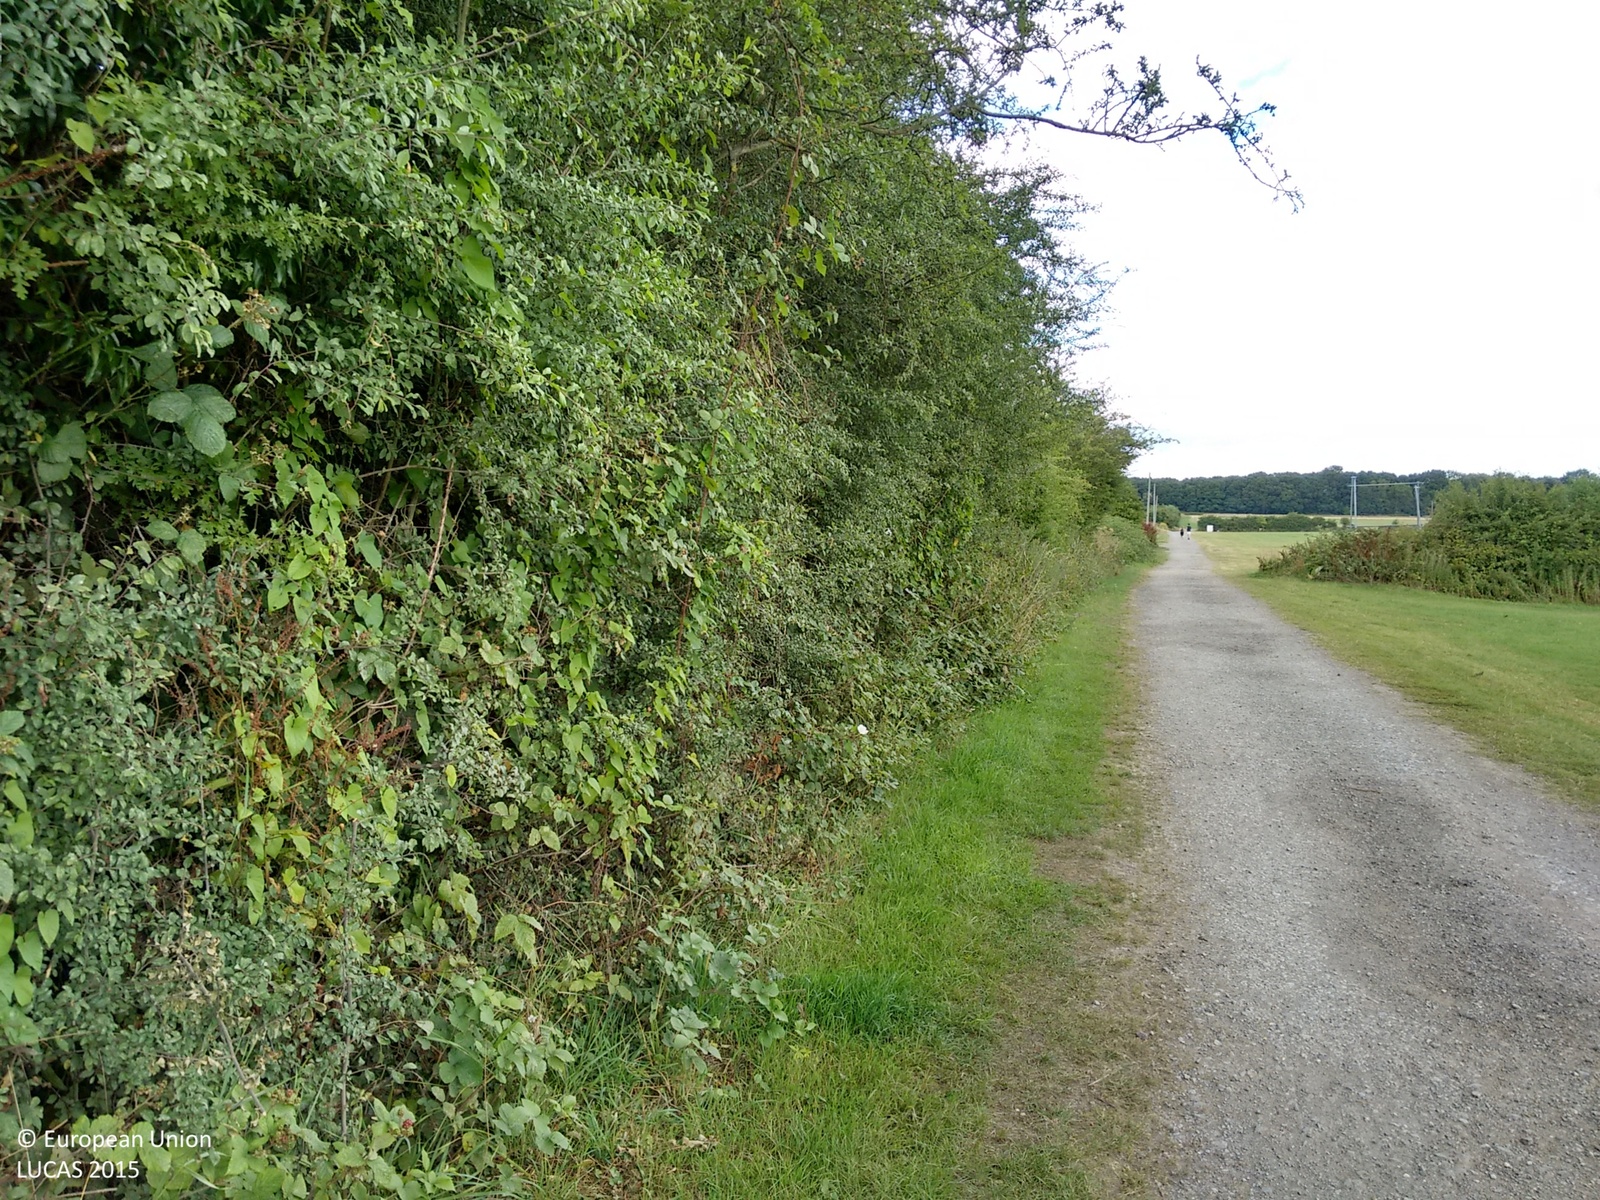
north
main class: Shrubland
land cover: Shrubland with sparse tree cover
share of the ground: > 75 %
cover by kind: shrubs 95 %, broadleaved forest trees 5 %
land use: Agriculture (excluding fallow land and kitchen gardens)
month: July
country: GB
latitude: 51.5510
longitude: -0.4648
